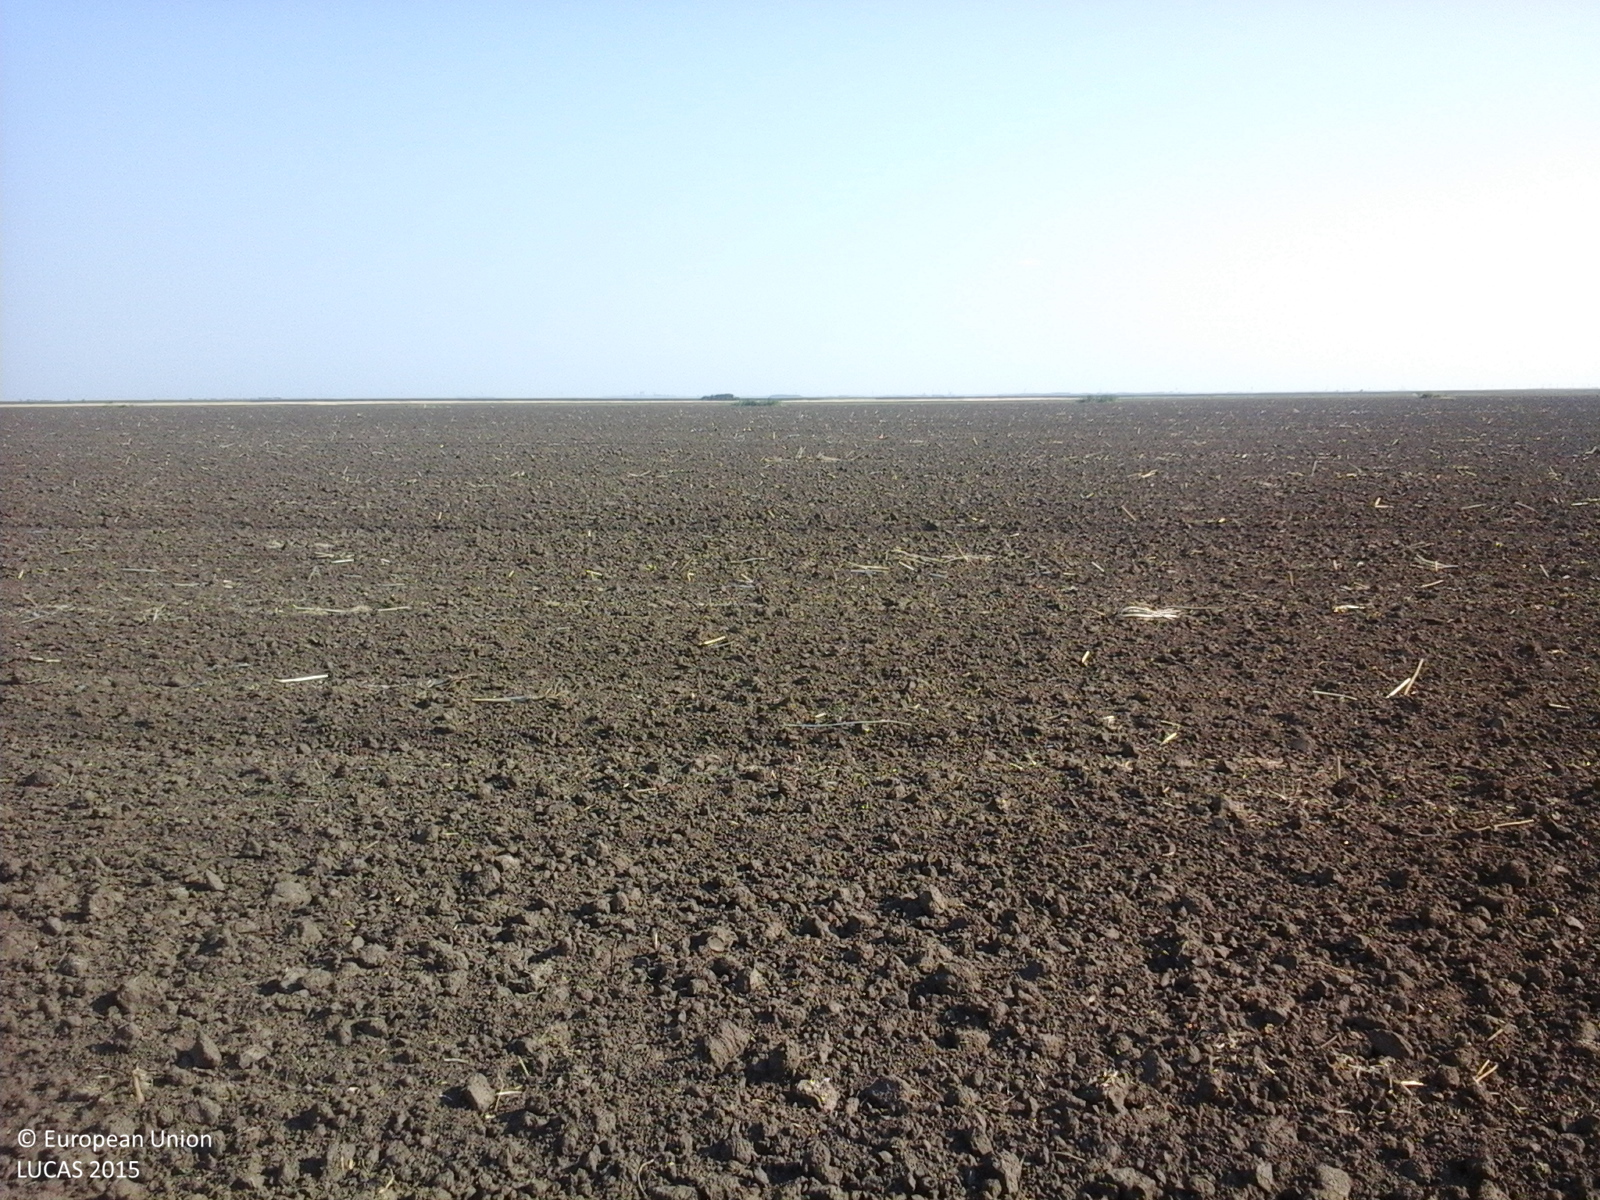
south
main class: Cropland
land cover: Common wheat
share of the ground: < 10 %
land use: Agriculture (excluding fallow land and kitchen gardens)
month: July
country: RO
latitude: 44.6997
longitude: 27.3418
